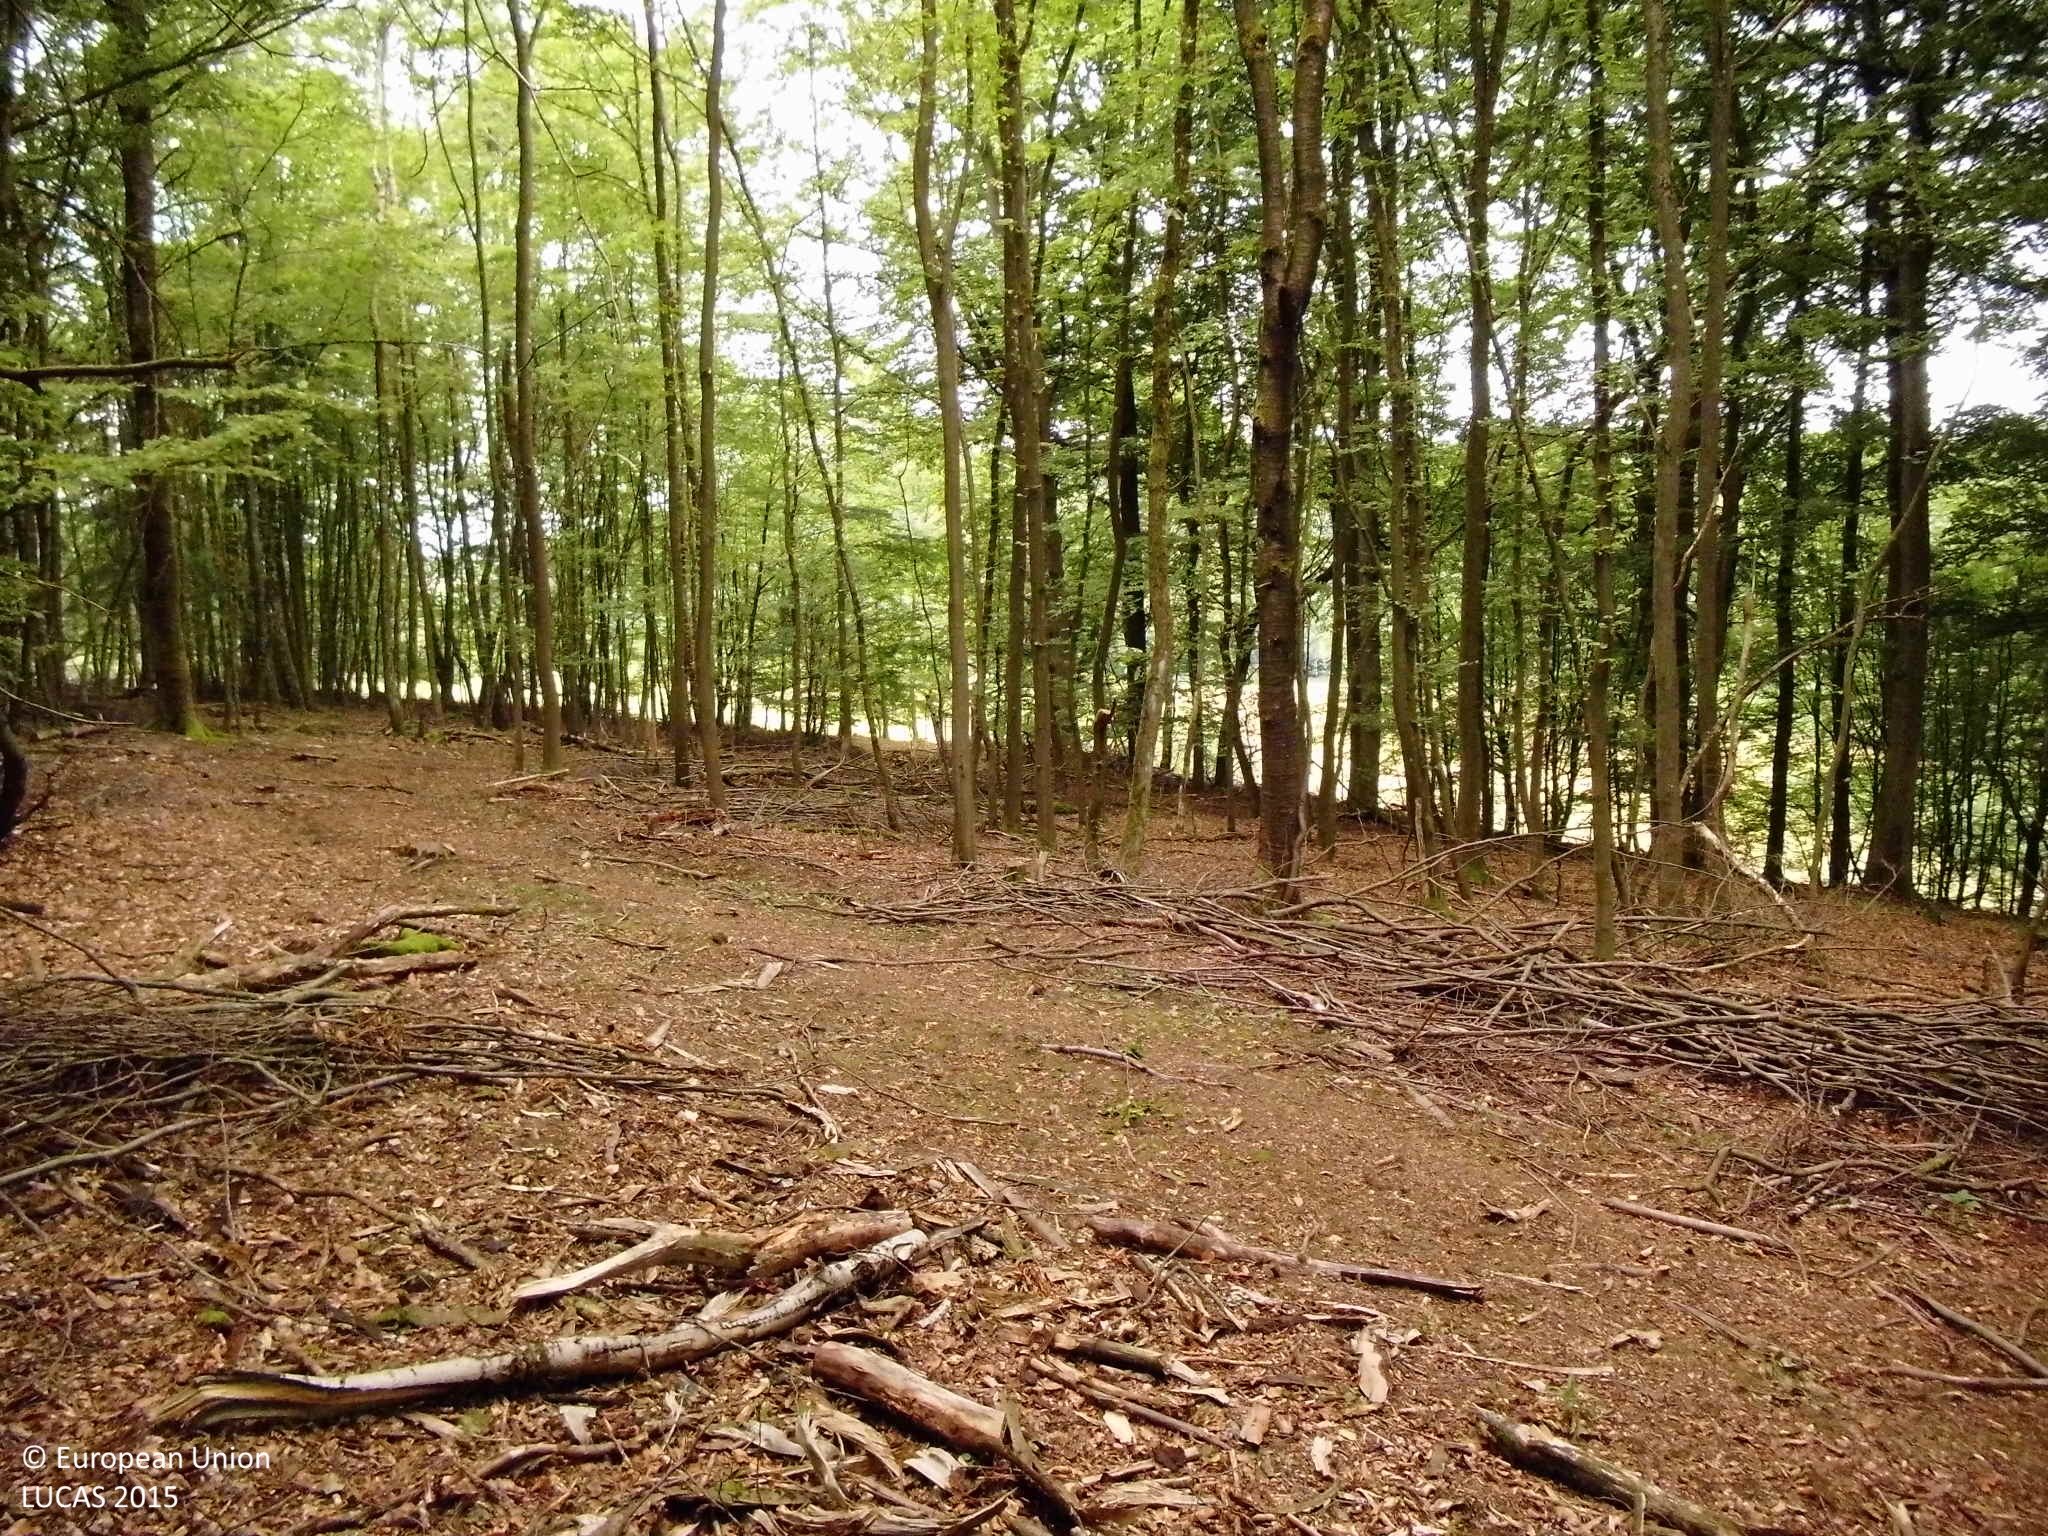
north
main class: Woodland
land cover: Broadleaved woodland
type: mesophytic deciduous forest
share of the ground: > 75 %
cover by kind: broadleaved forest trees 90 %, herbaceous plants 5 %, unconsolidated bare surface 5 %
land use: Forestry
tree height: > 5 m
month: August
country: DE
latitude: 50.6245
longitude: 8.5444
